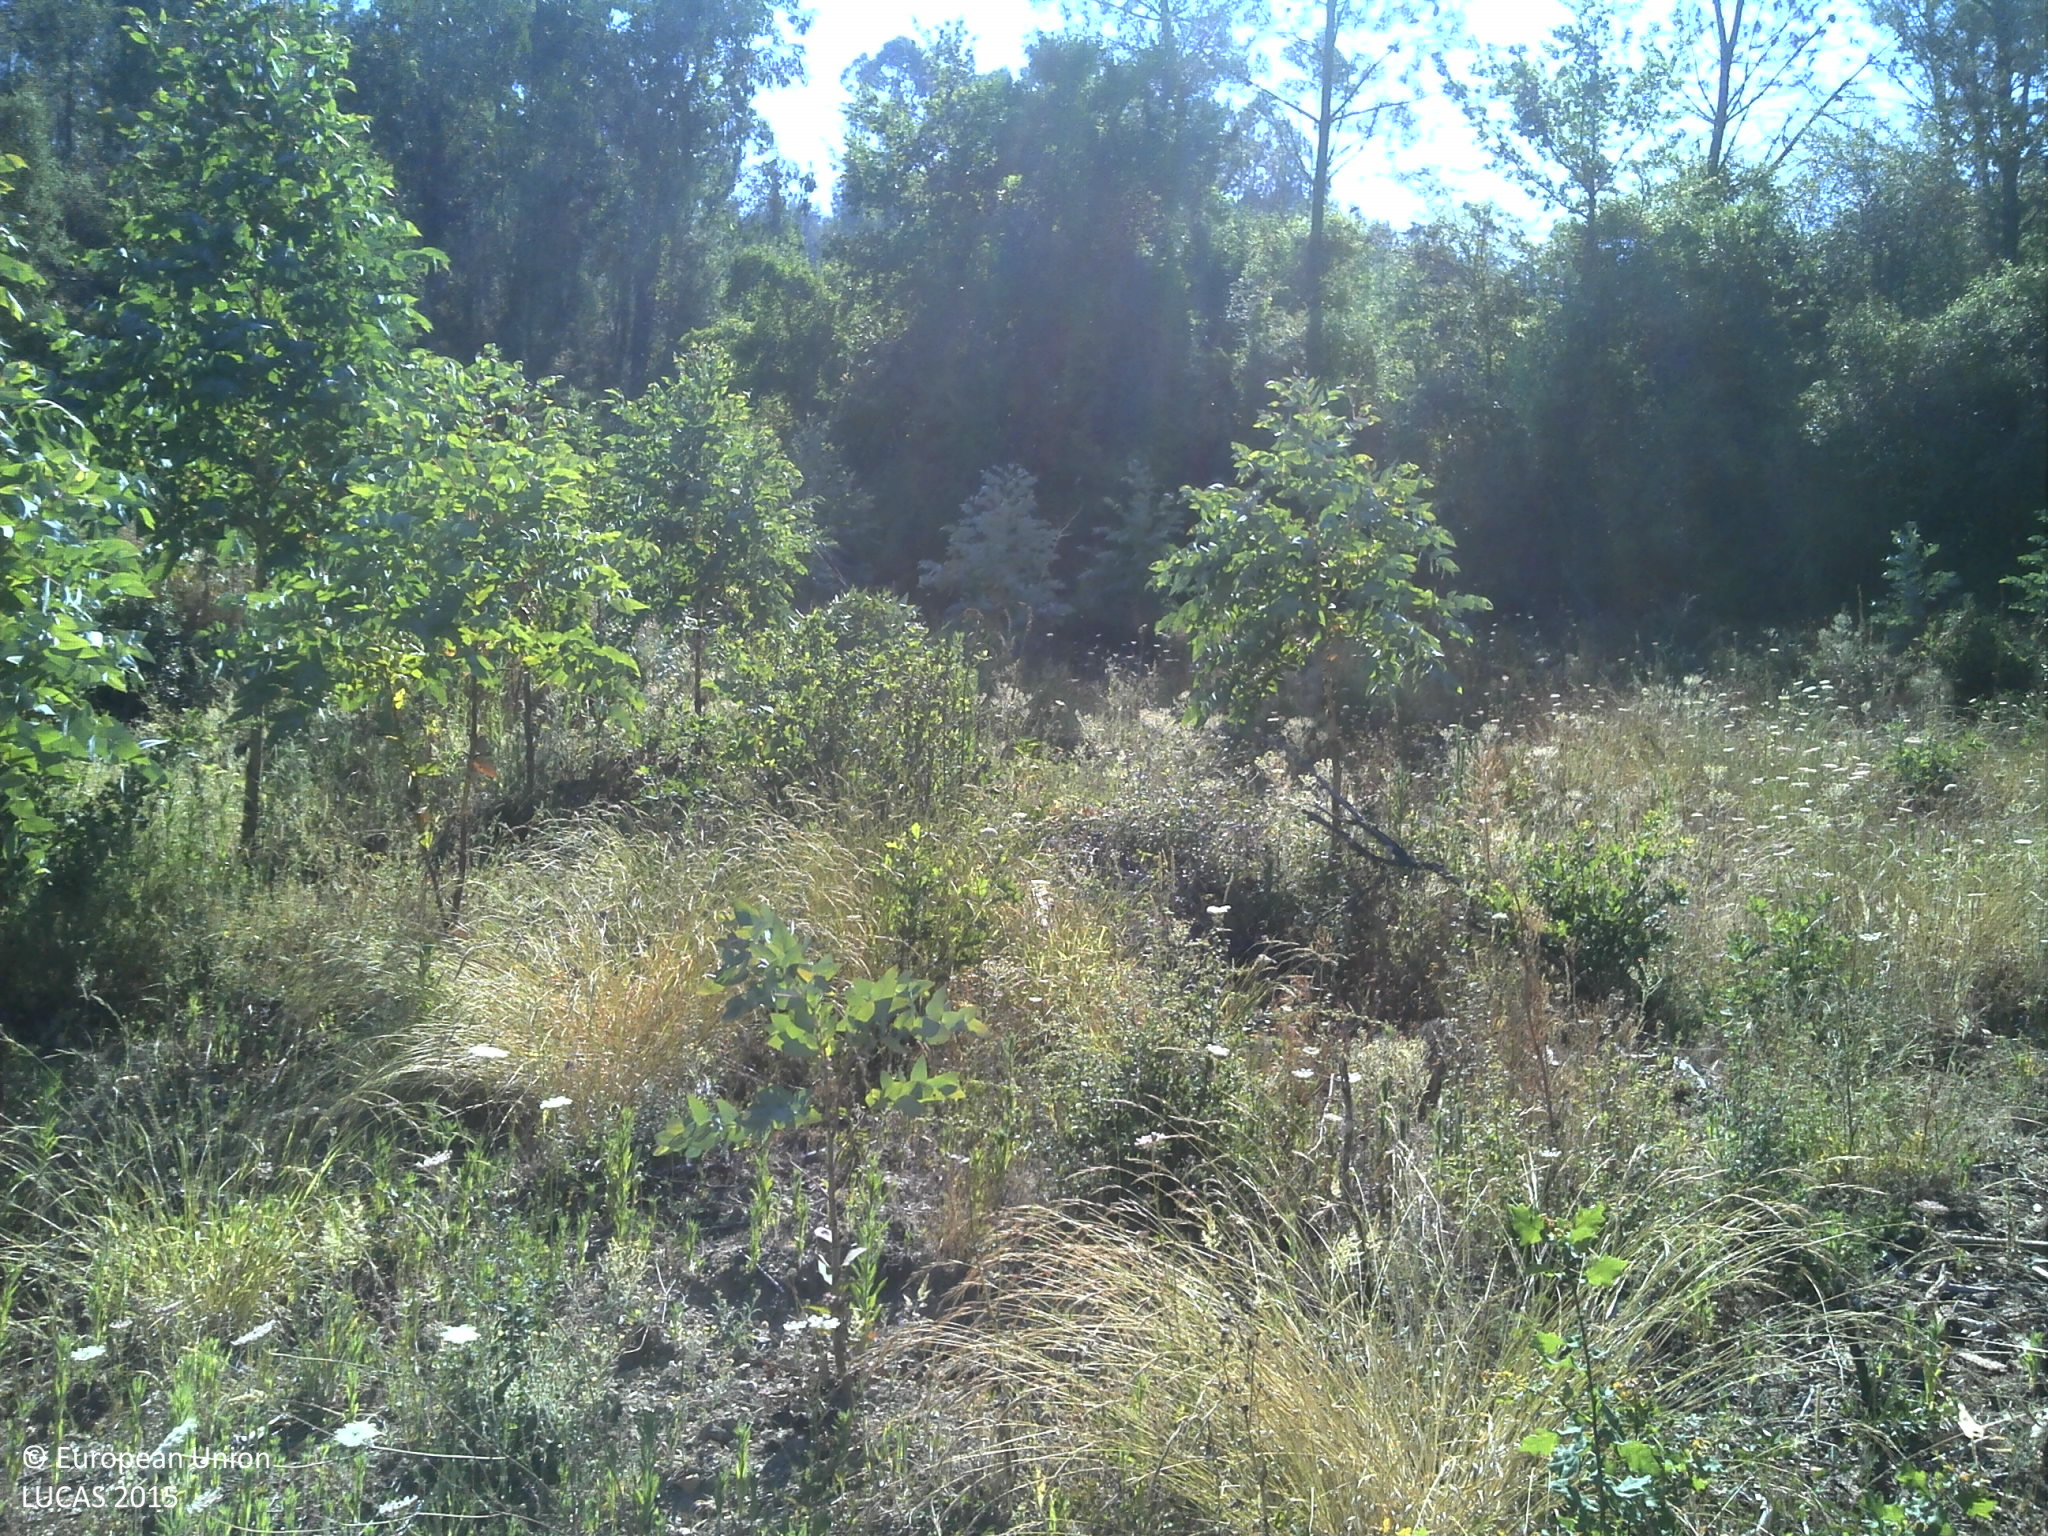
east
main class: Woodland
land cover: Broadleaved woodland
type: exotic forest
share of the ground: 10 - 25 %
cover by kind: unconsolidated bare surface 50 %, broadleaved forest trees 25 %, shrubs 15 %, herbaceous plants 10 %
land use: Forestry
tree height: < 5 m
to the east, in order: Broadleaved woodland; Tracks; Broadleaved woodland; Shrubland with sparse tree cover; Pine dominated coniferous woodland; Tracks; Broadleaved woodland; Tracks; Broadleaved woodland
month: July
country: PT
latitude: 40.2285
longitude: -8.1154
